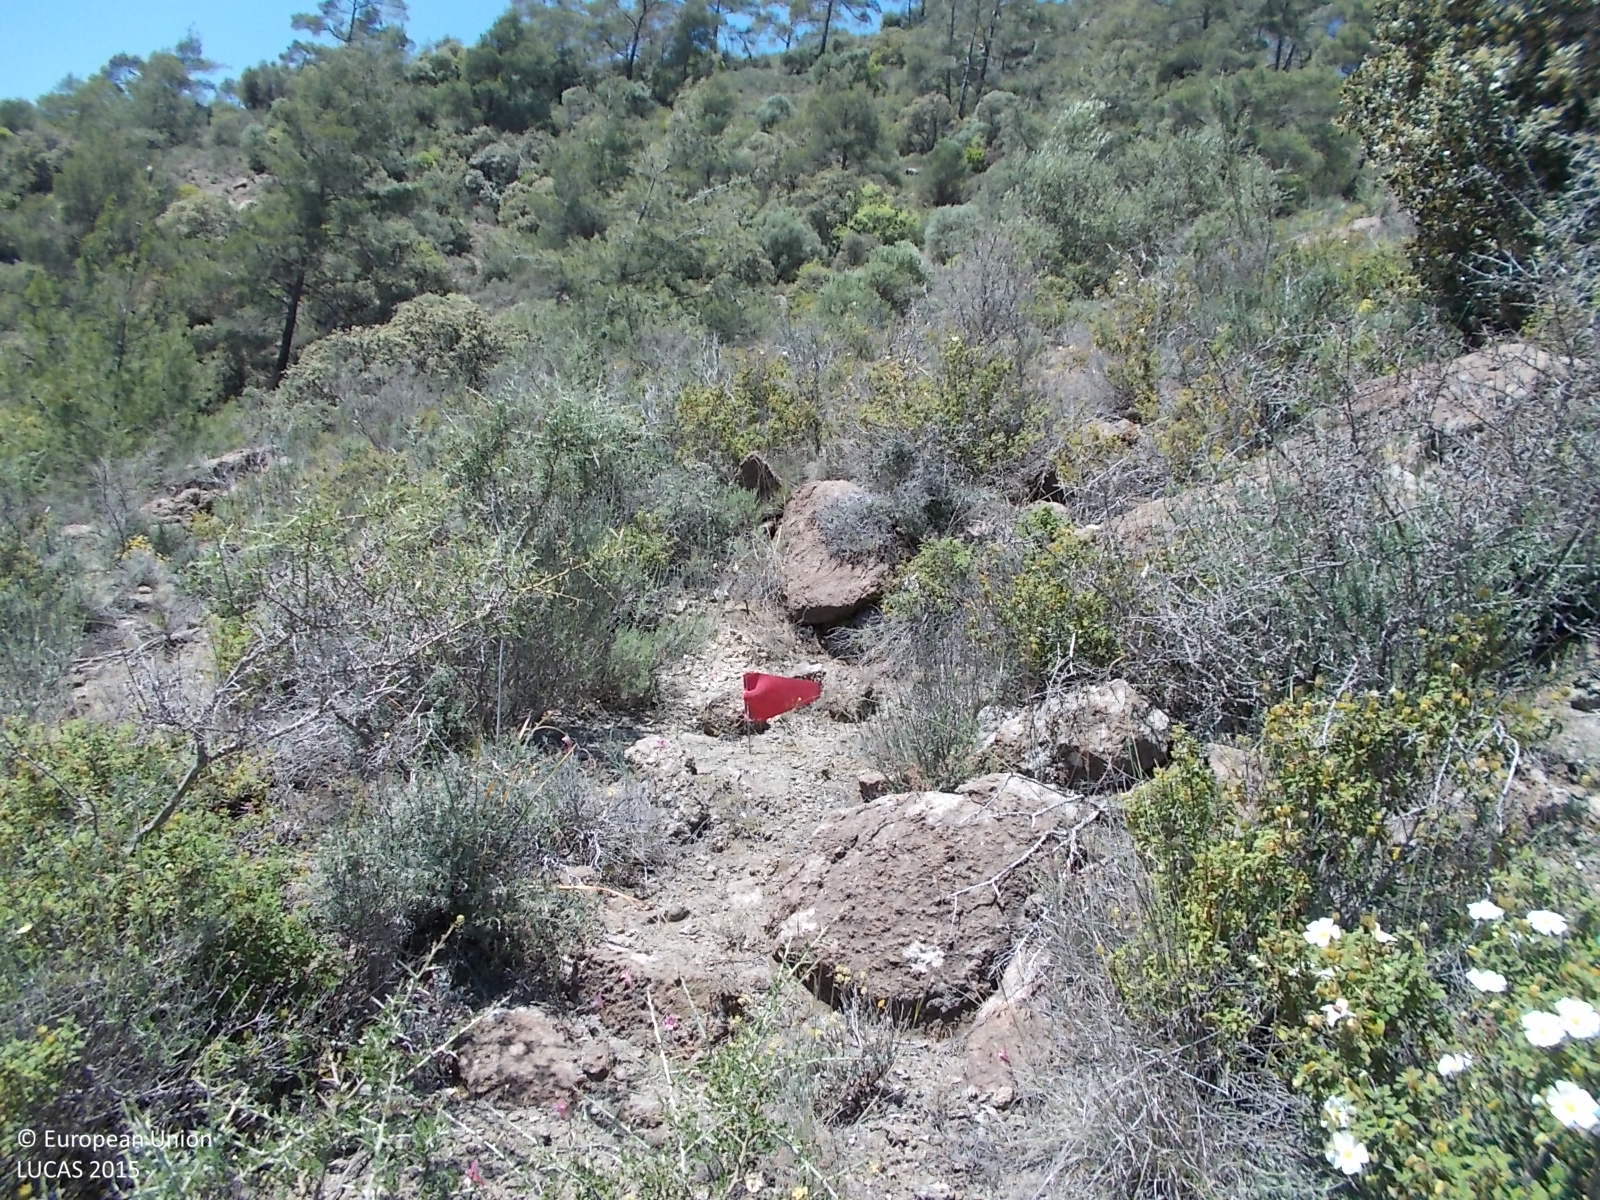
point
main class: Shrubland
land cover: Shrubland with sparse tree cover
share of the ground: > 75 %
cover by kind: shrubs 75 %, unconsolidated bare surface 20 %, broadleaved forest trees 5 %
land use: Semi-natural and natural areas not in use
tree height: < 5 m
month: May
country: CY
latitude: 34.8236
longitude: 33.0308
